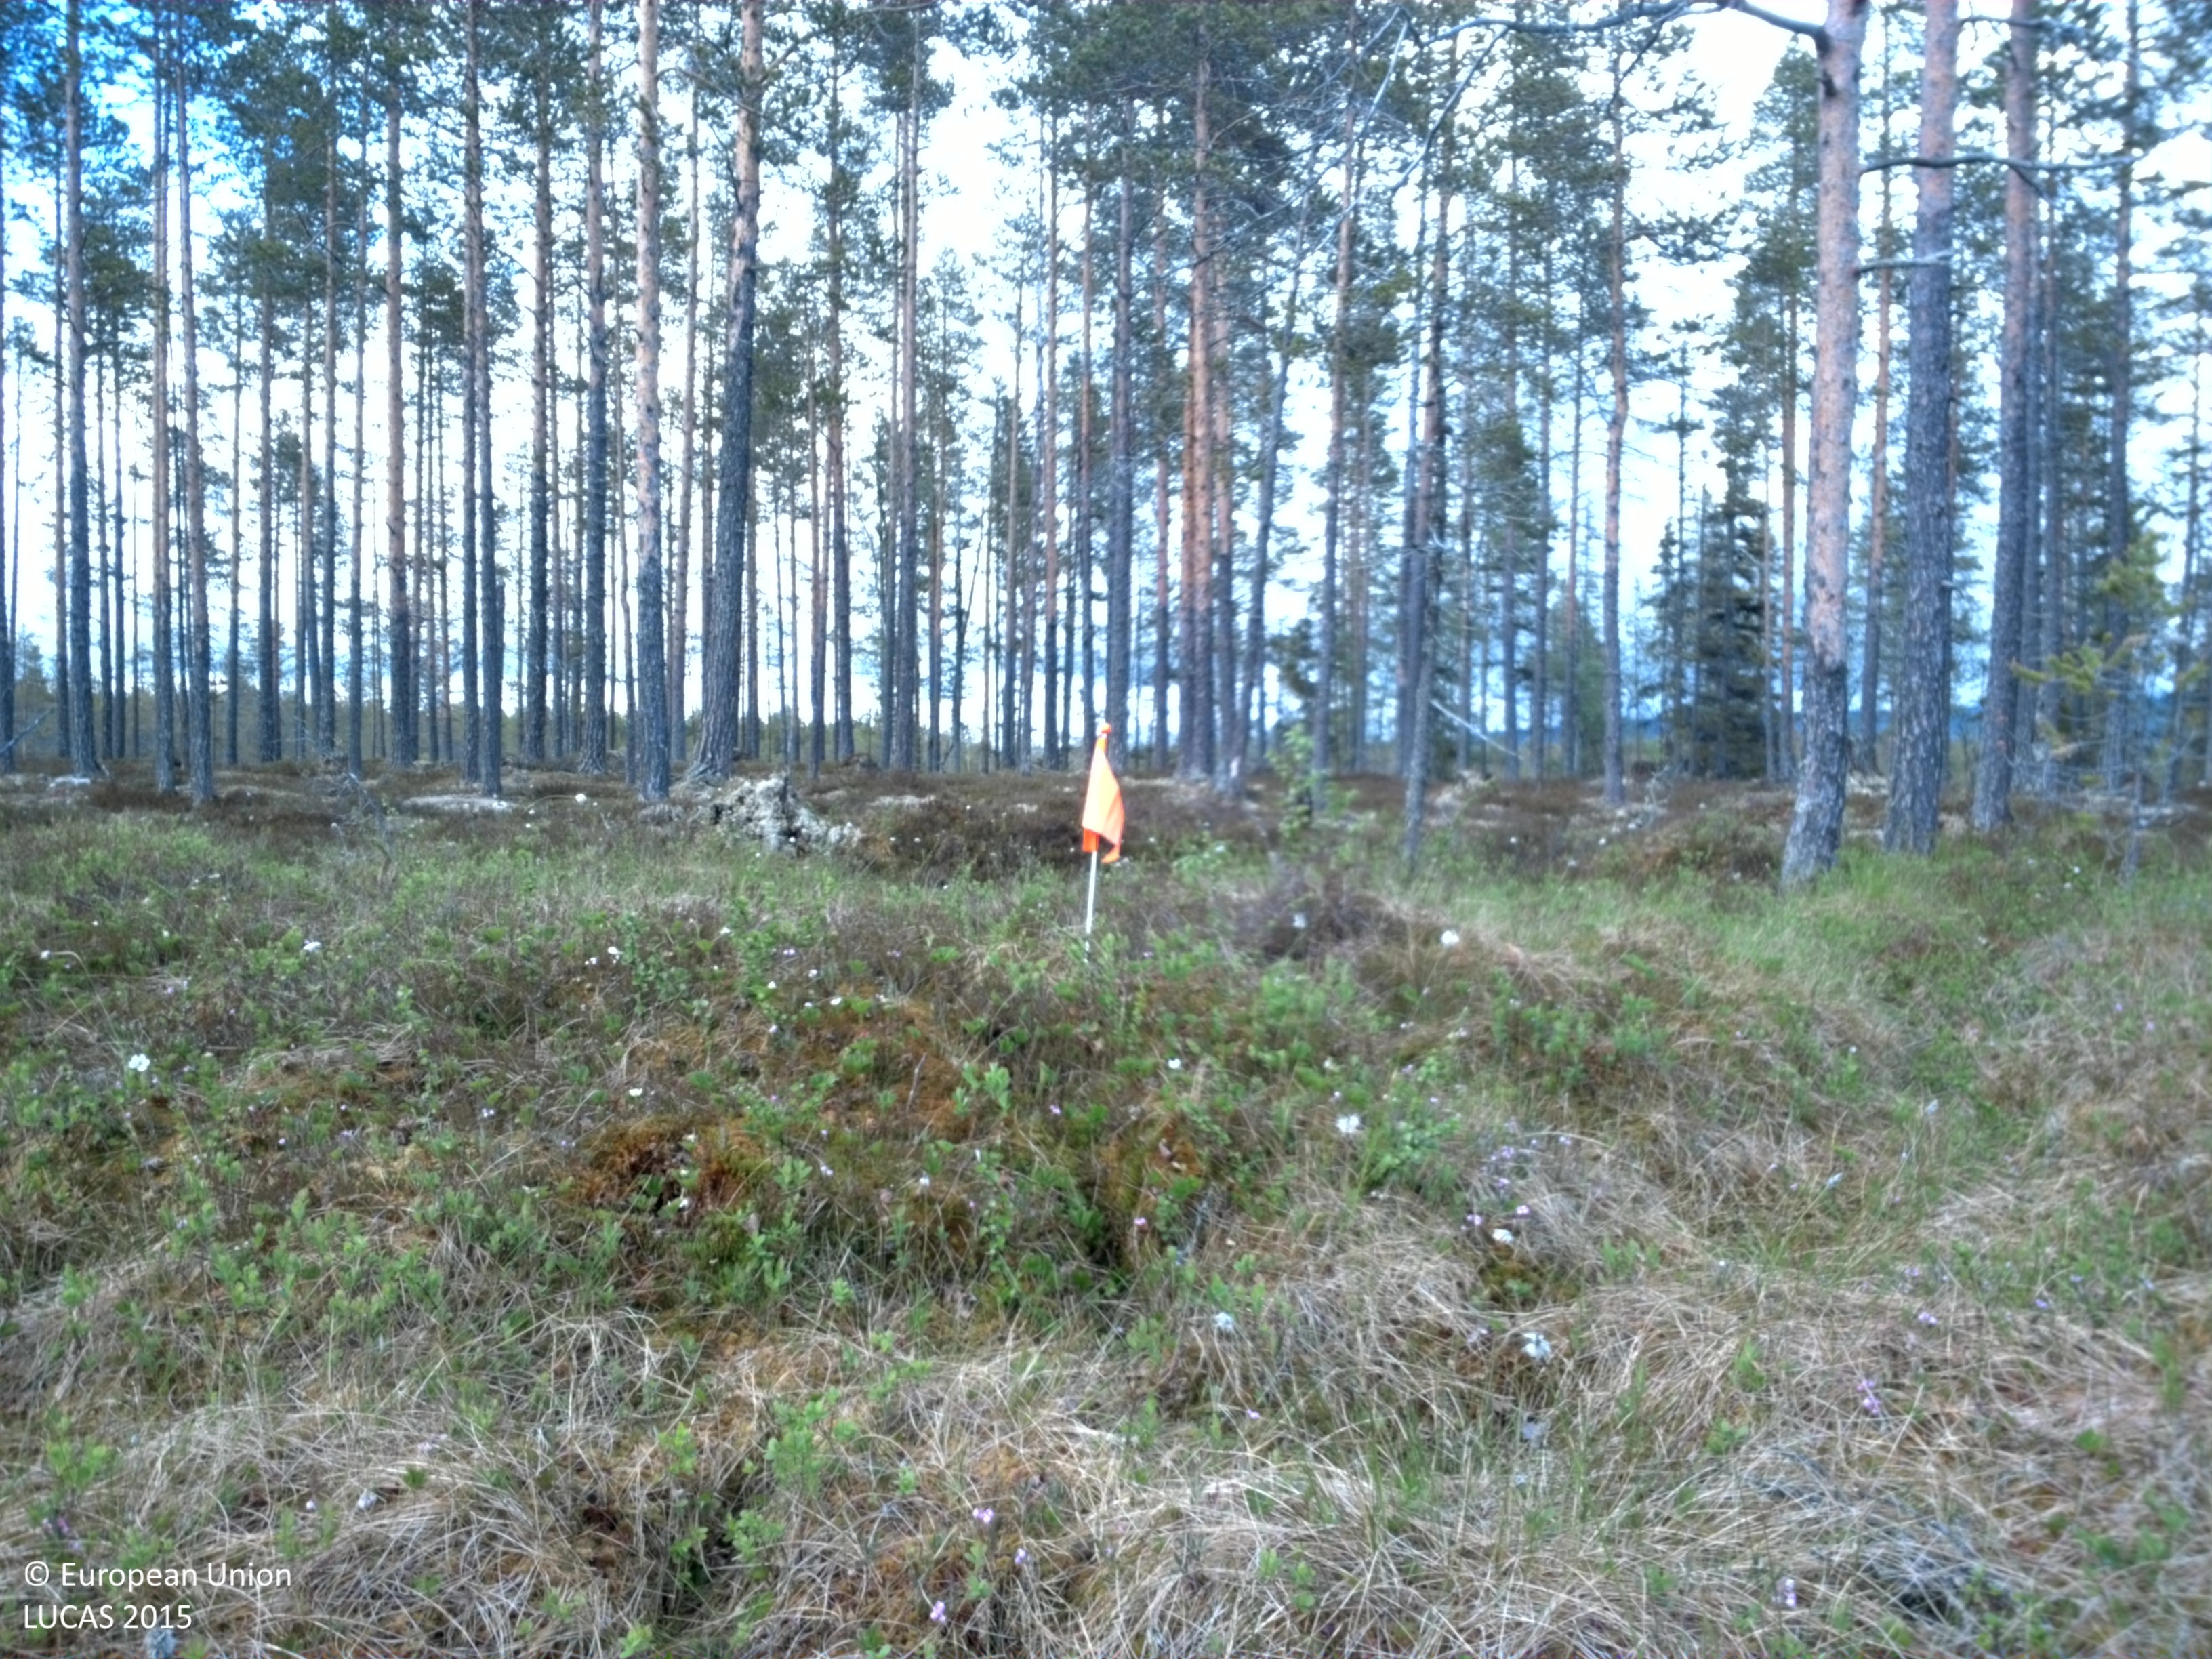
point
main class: Woodland
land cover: Pine dominated coniferous woodland
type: boreal forest
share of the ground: 10 - 25 %
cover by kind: shrubs 50 %, lichens and mosses 30 %, coniferous forest trees 15 %, herbaceous plants 5 %
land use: Forestry
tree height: > 5 m
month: June
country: SE
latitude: 62.0971
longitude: 13.7202
